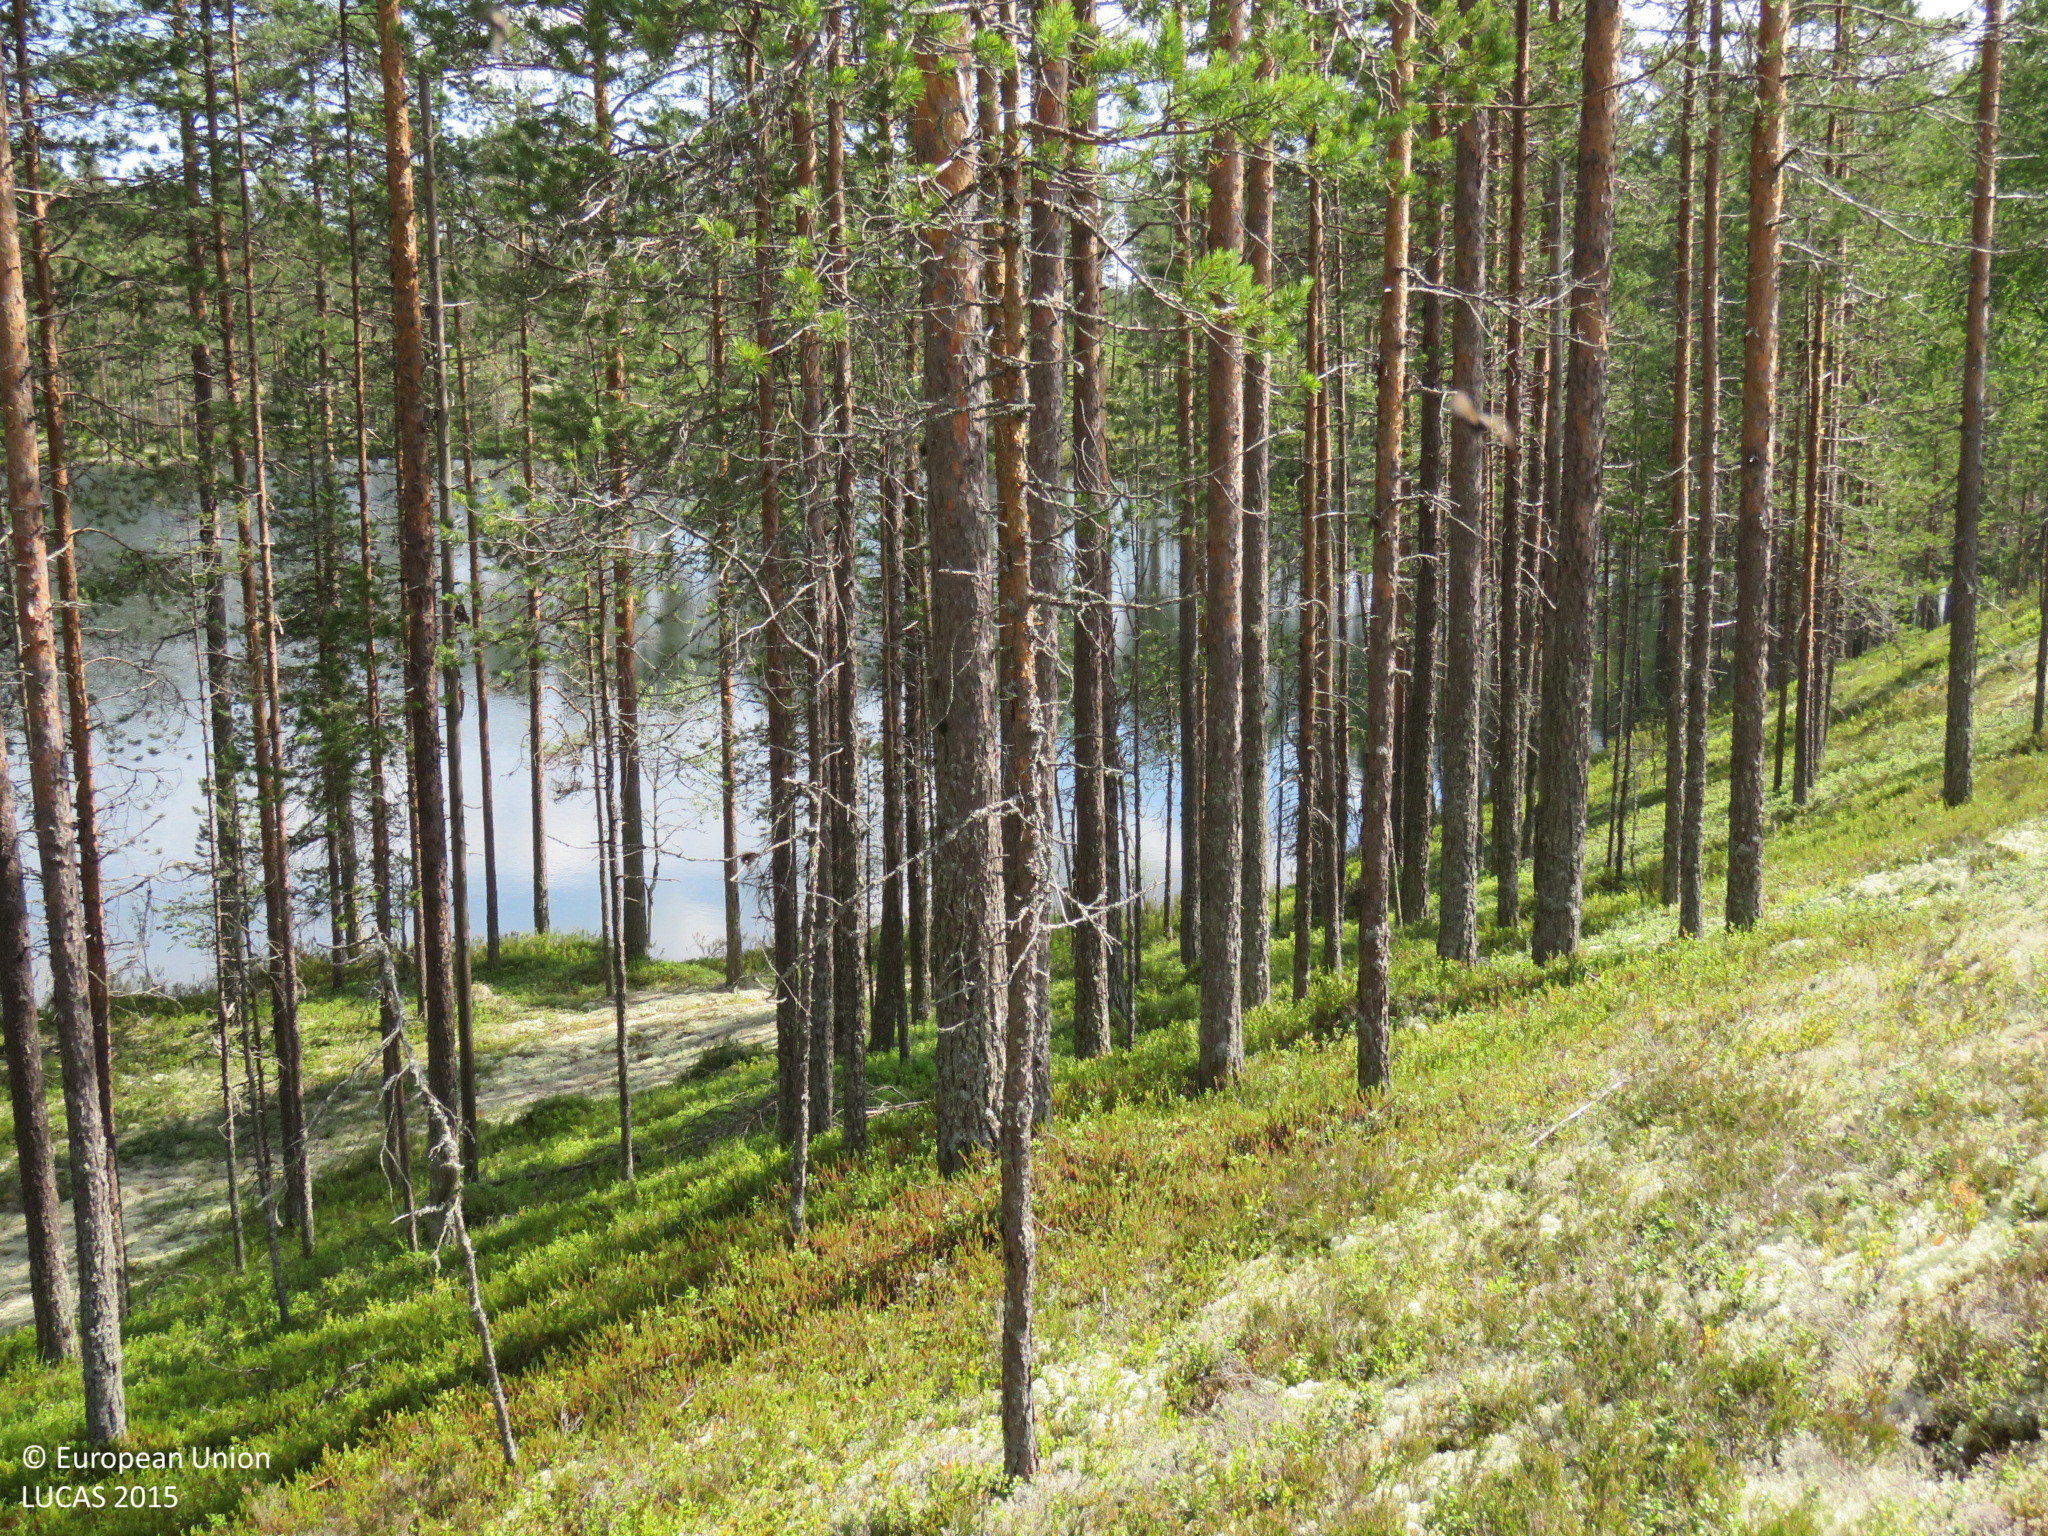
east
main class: Woodland
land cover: Pine dominated coniferous woodland
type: boreal forest
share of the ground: > 75 %
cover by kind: coniferous forest trees 75 %, lichens and mosses 15 %, shrubs 10 %
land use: Forestry
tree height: > 5 m
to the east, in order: Pine dominated coniferous woodland; Inland fresh water bodies; Pine dominated coniferous woodland
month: July
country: FI
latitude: 64.5342
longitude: 26.6049
